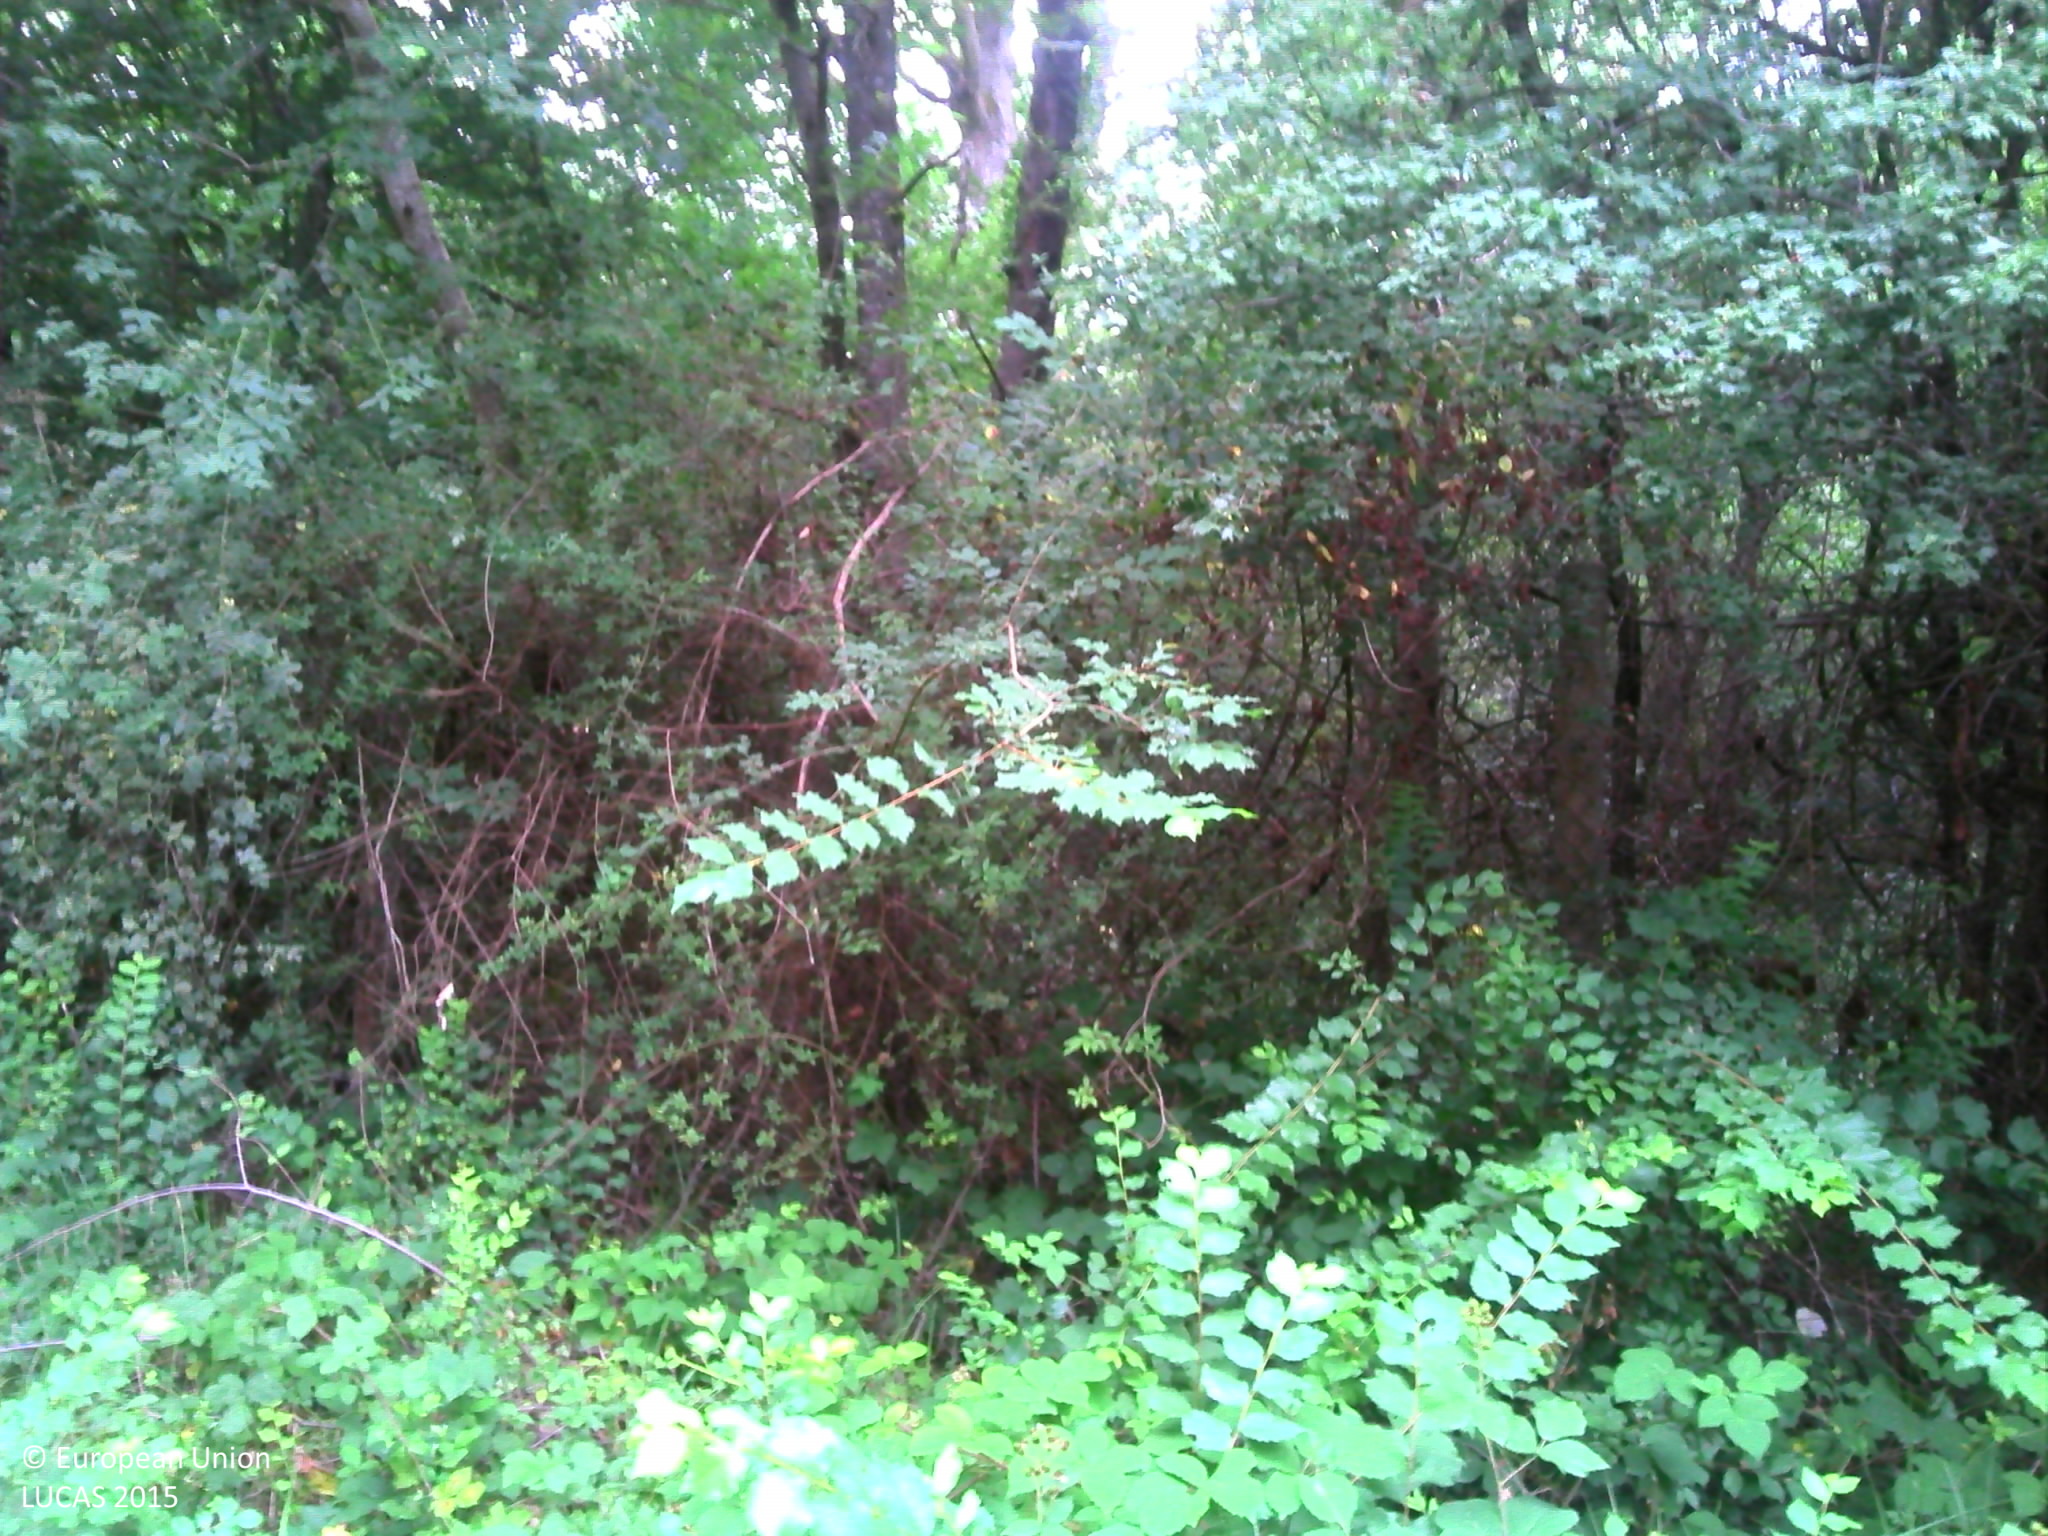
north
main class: Woodland
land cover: Broadleaved woodland
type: acidophilous oak and oak-birch forest
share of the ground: > 75 %
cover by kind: broadleaved forest trees 65 %, lichens and mosses 15 %, herbaceous plants 10 %, consolidated bare surface 5 %, unconsolidated bare surface 5 %
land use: Community services
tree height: > 5 m
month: July
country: FR
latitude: 48.5515
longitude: 2.5792
